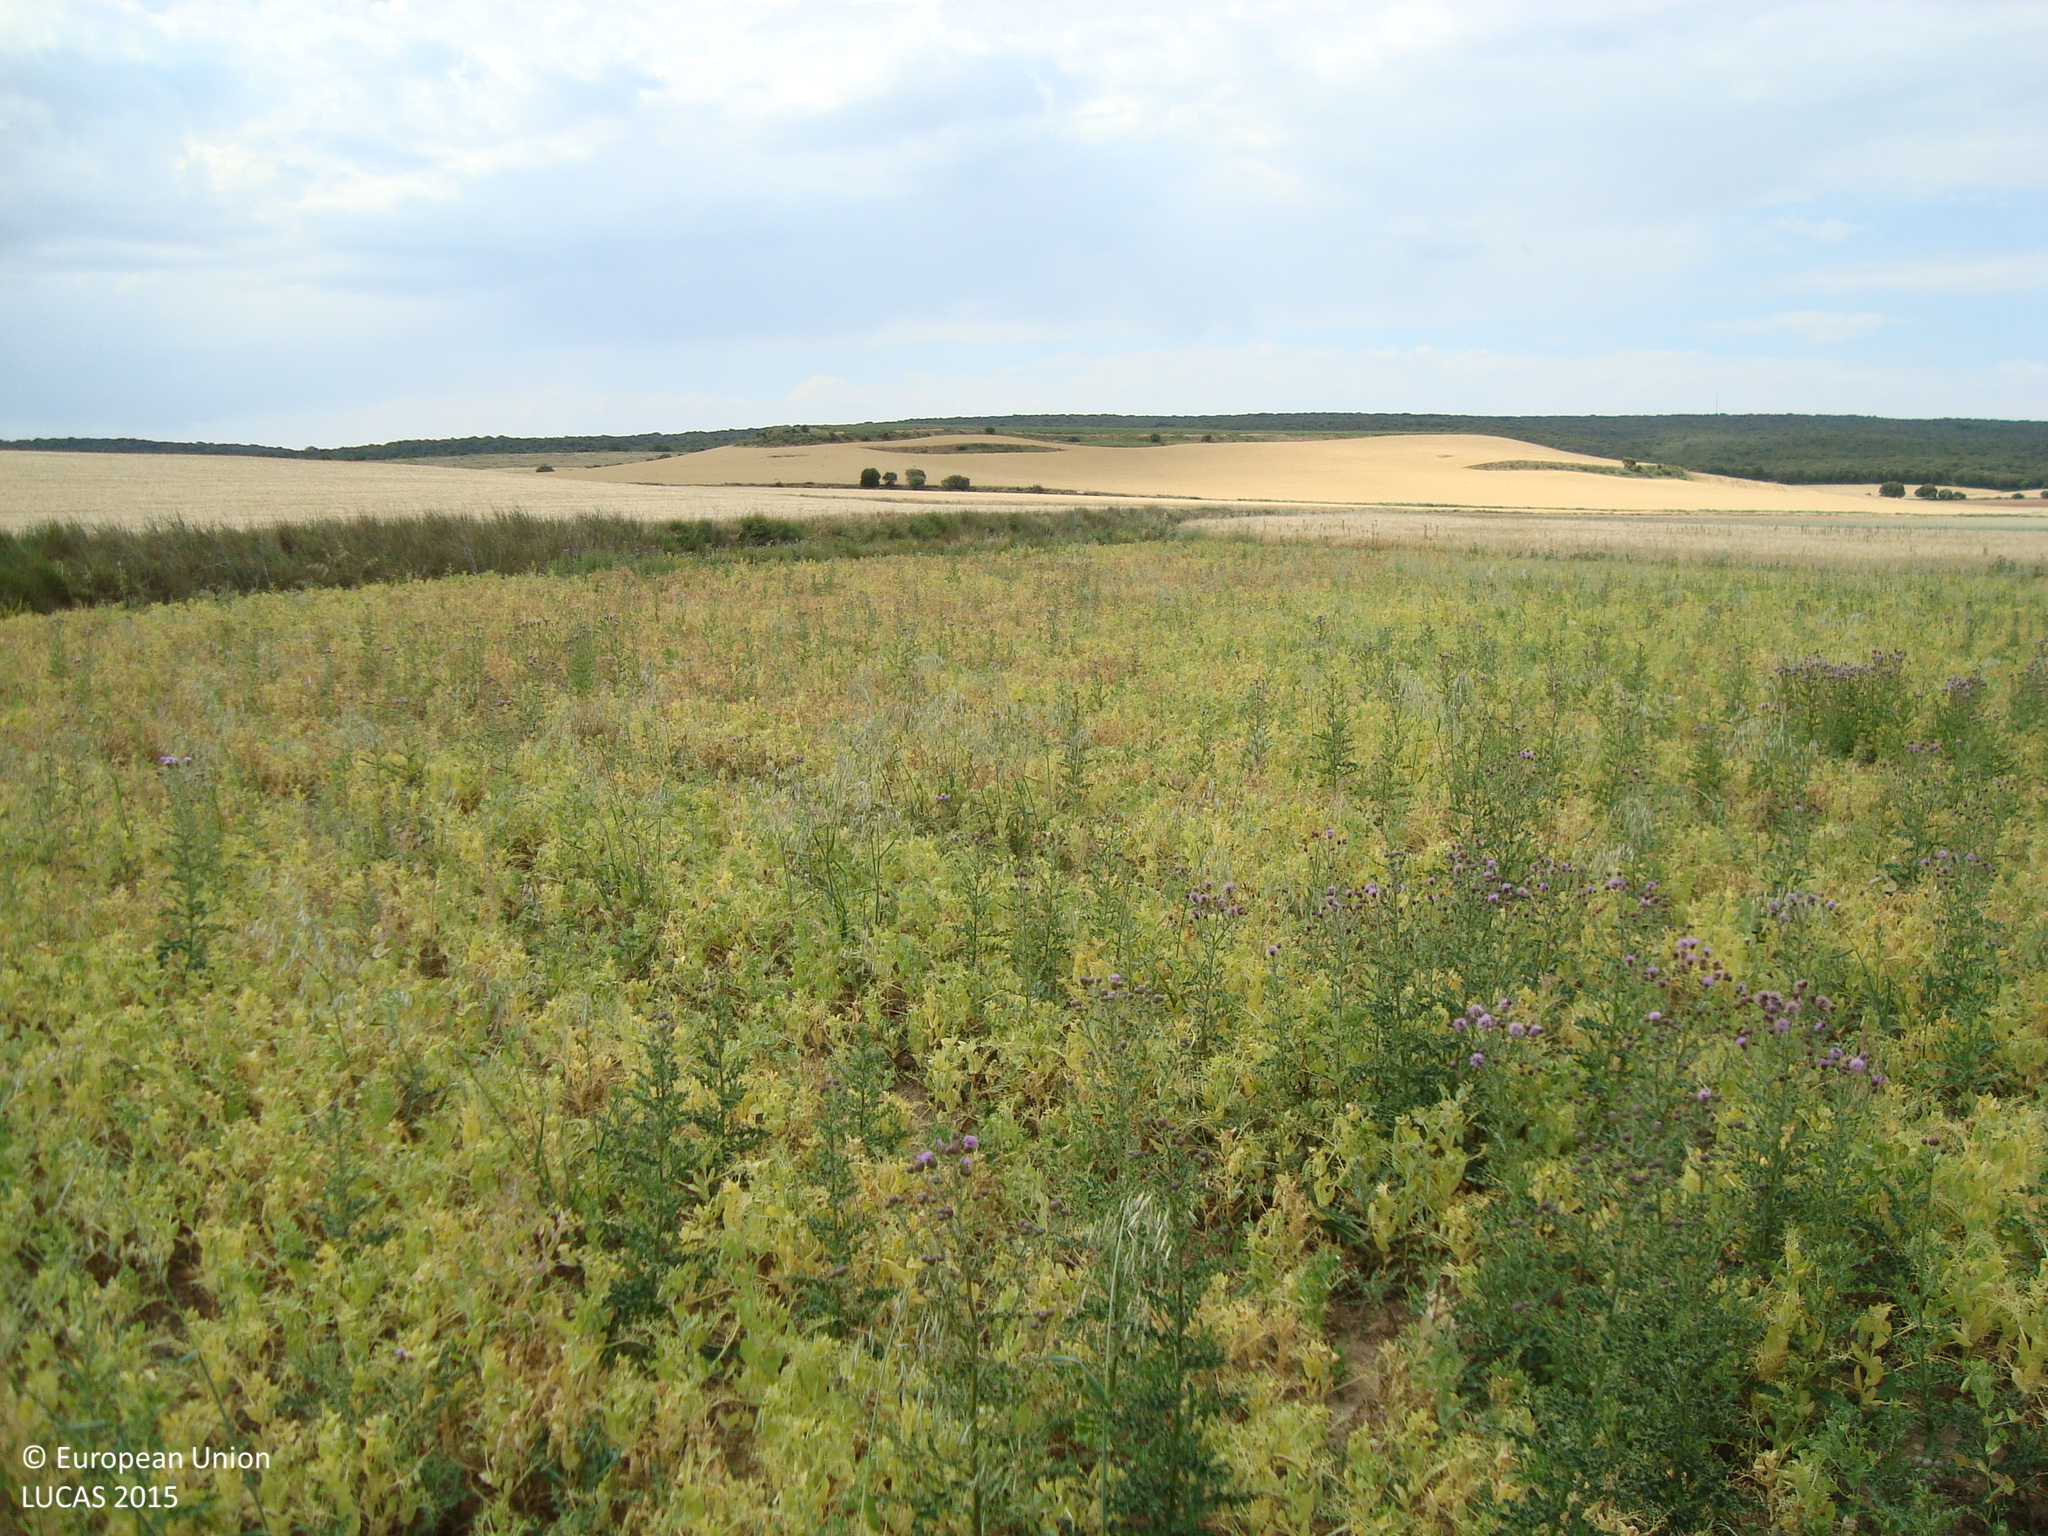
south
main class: Cropland
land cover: Dry pulses
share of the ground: > 75 %
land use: Agriculture (excluding fallow land and kitchen gardens)
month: June
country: ES
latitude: 41.9768
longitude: -3.6814
